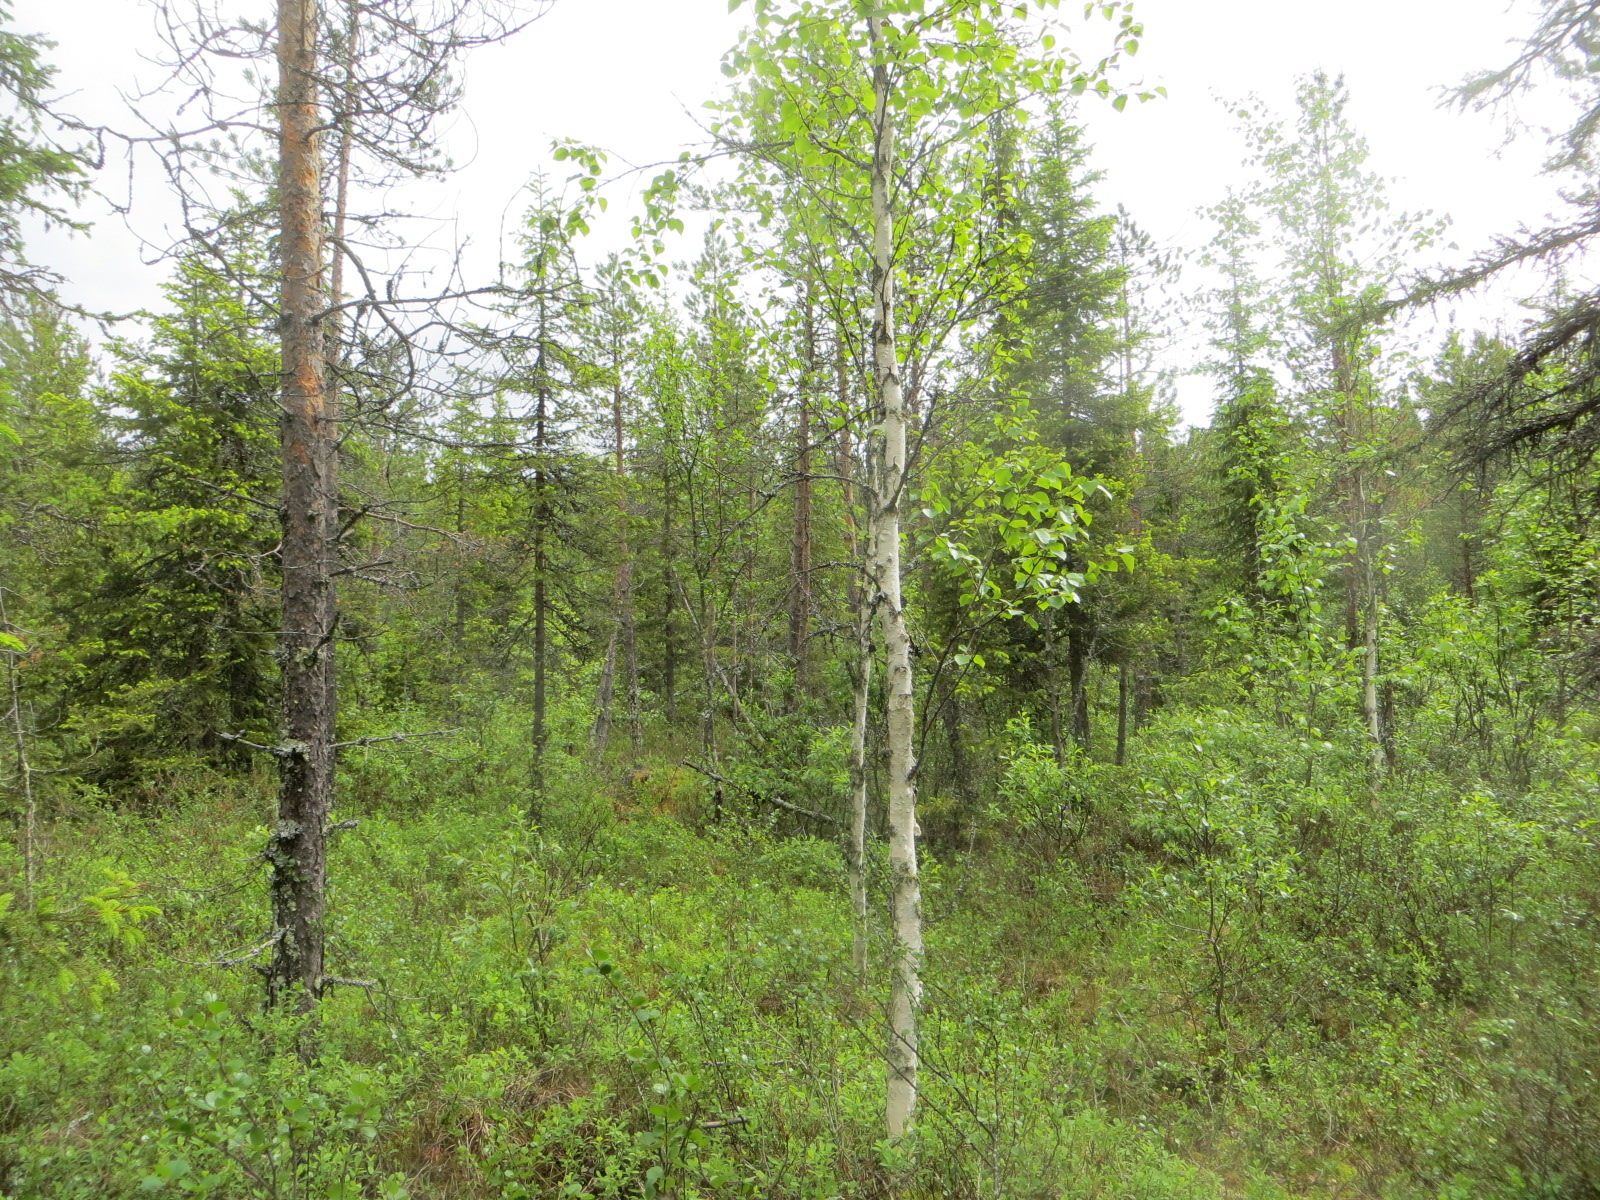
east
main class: Woodland
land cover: Other mixed woodland
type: boreal forest
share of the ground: > 75 %
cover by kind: coniferous forest trees 50 %, broadleaved forest trees 35 %, shrubs 15 %
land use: Forestry
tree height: > 5 m
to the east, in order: Other mixed woodland; Ditches and canals; Other mixed woodland; Ditches and canals; Pine dominated mixed woodland; Paved roads, cycling and walking lanes; Ditches and canals; Tracks; Pine dominated mixed woodland; Tracks; Pine dominated coniferous woodland; Pine dominated mixed woodland
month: June
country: FI
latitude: 66.6220
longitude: 24.7499
